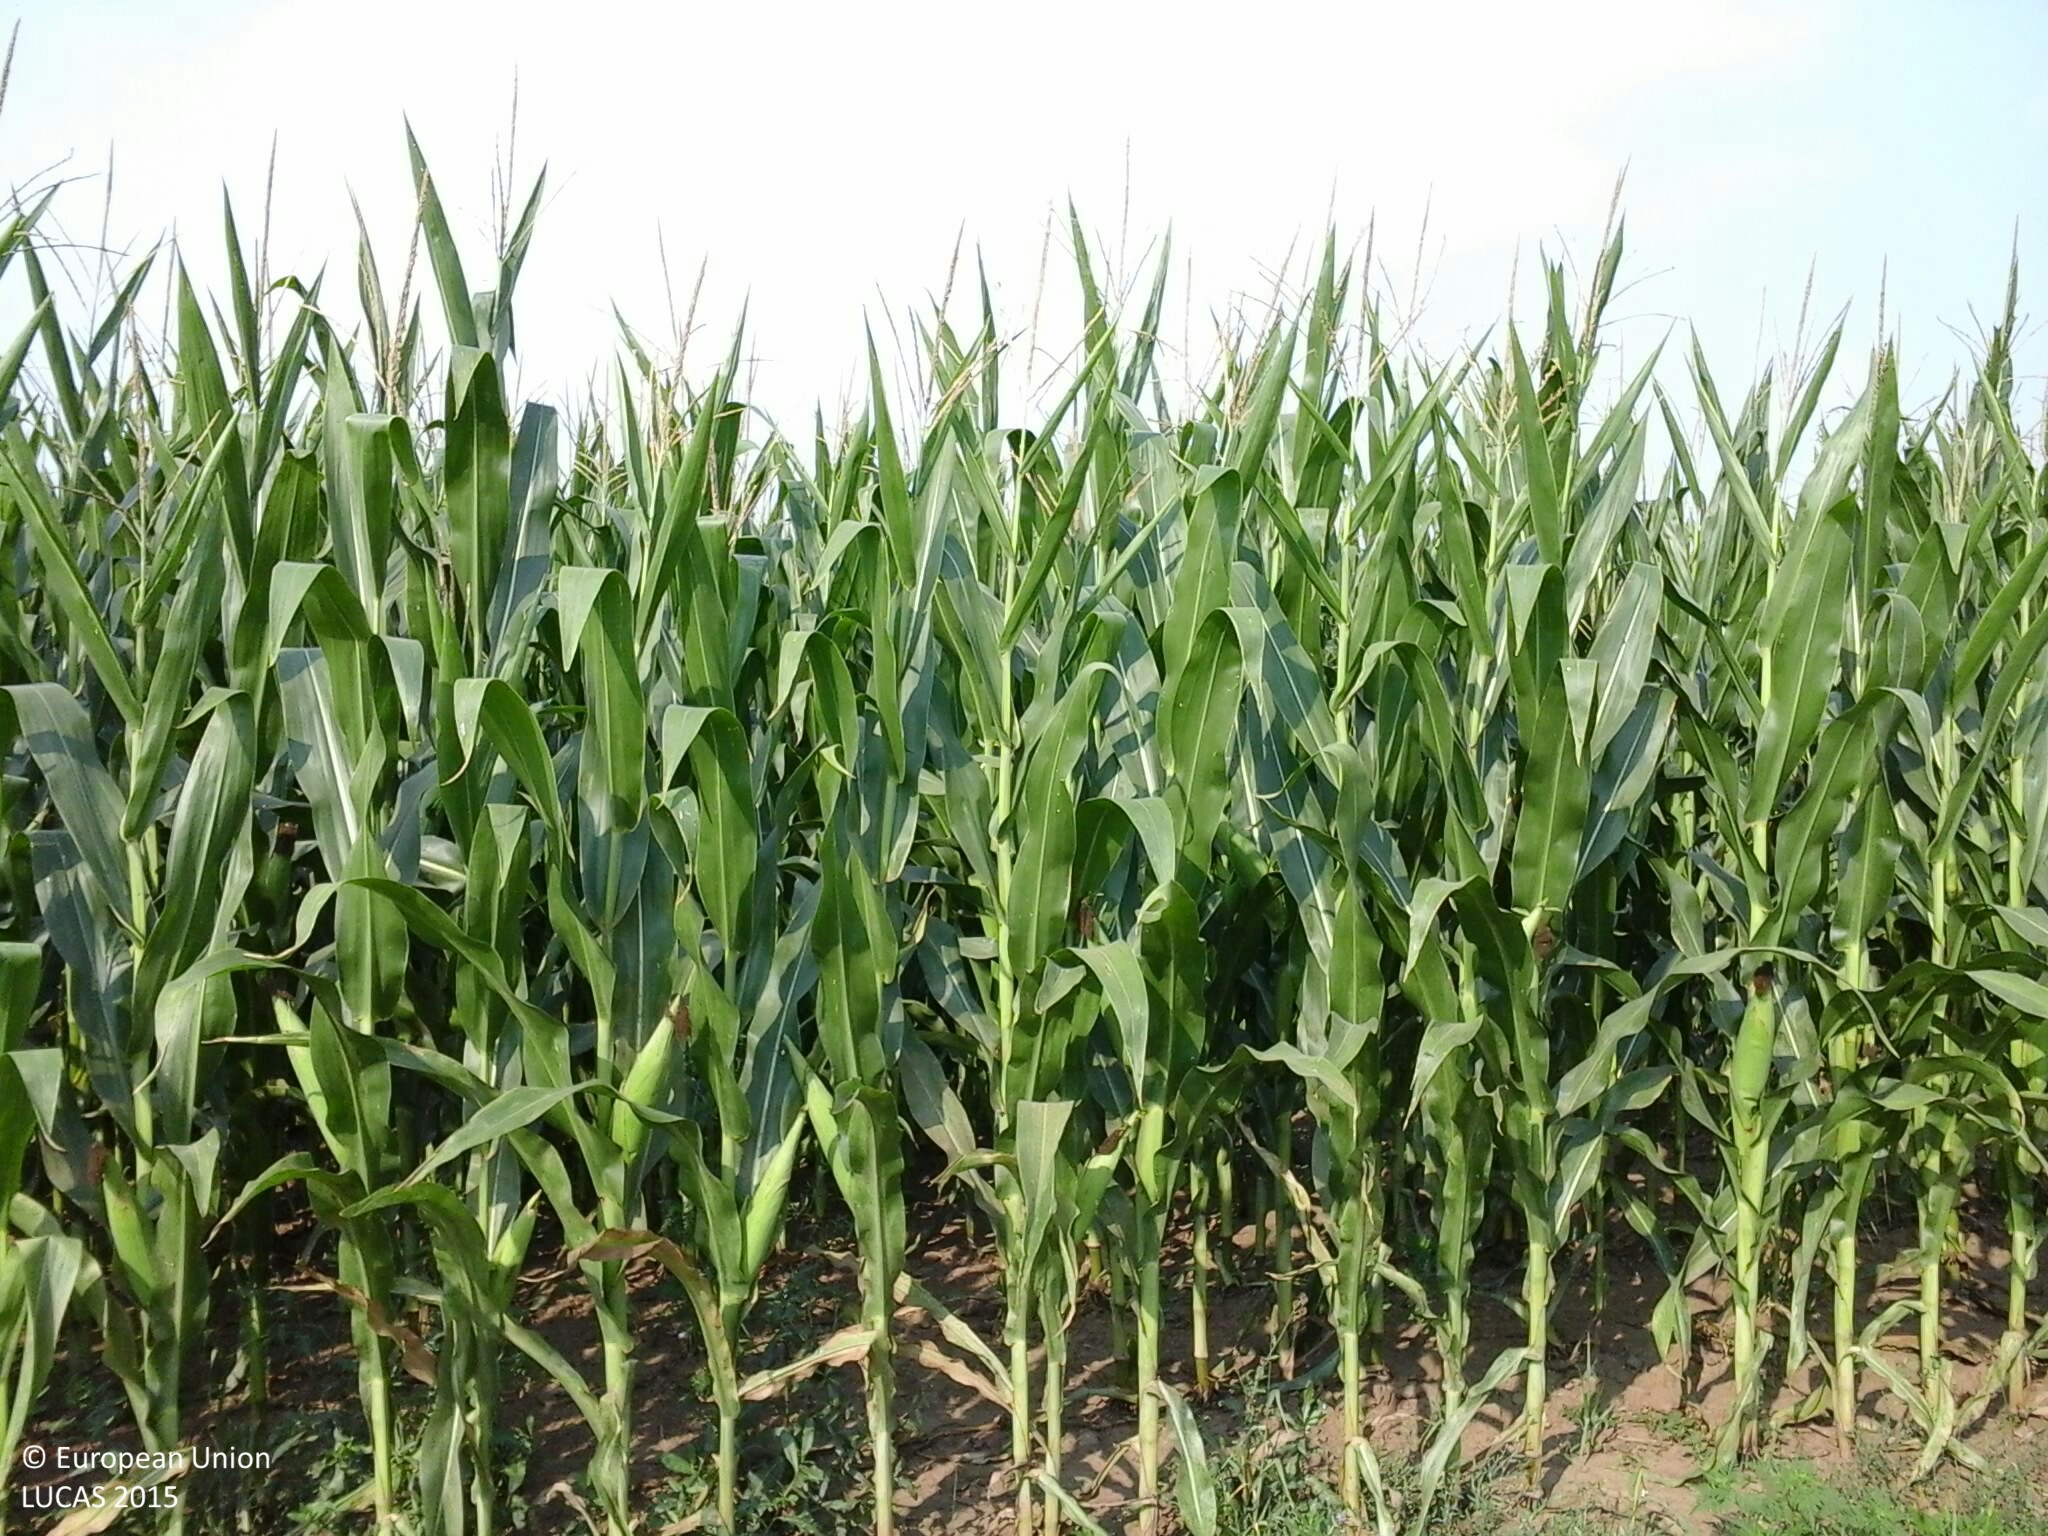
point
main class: Cropland
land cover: Maize
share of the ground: > 75 %
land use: Agriculture (excluding fallow land and kitchen gardens)
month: August
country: HU
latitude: 46.6630
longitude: 18.0459
